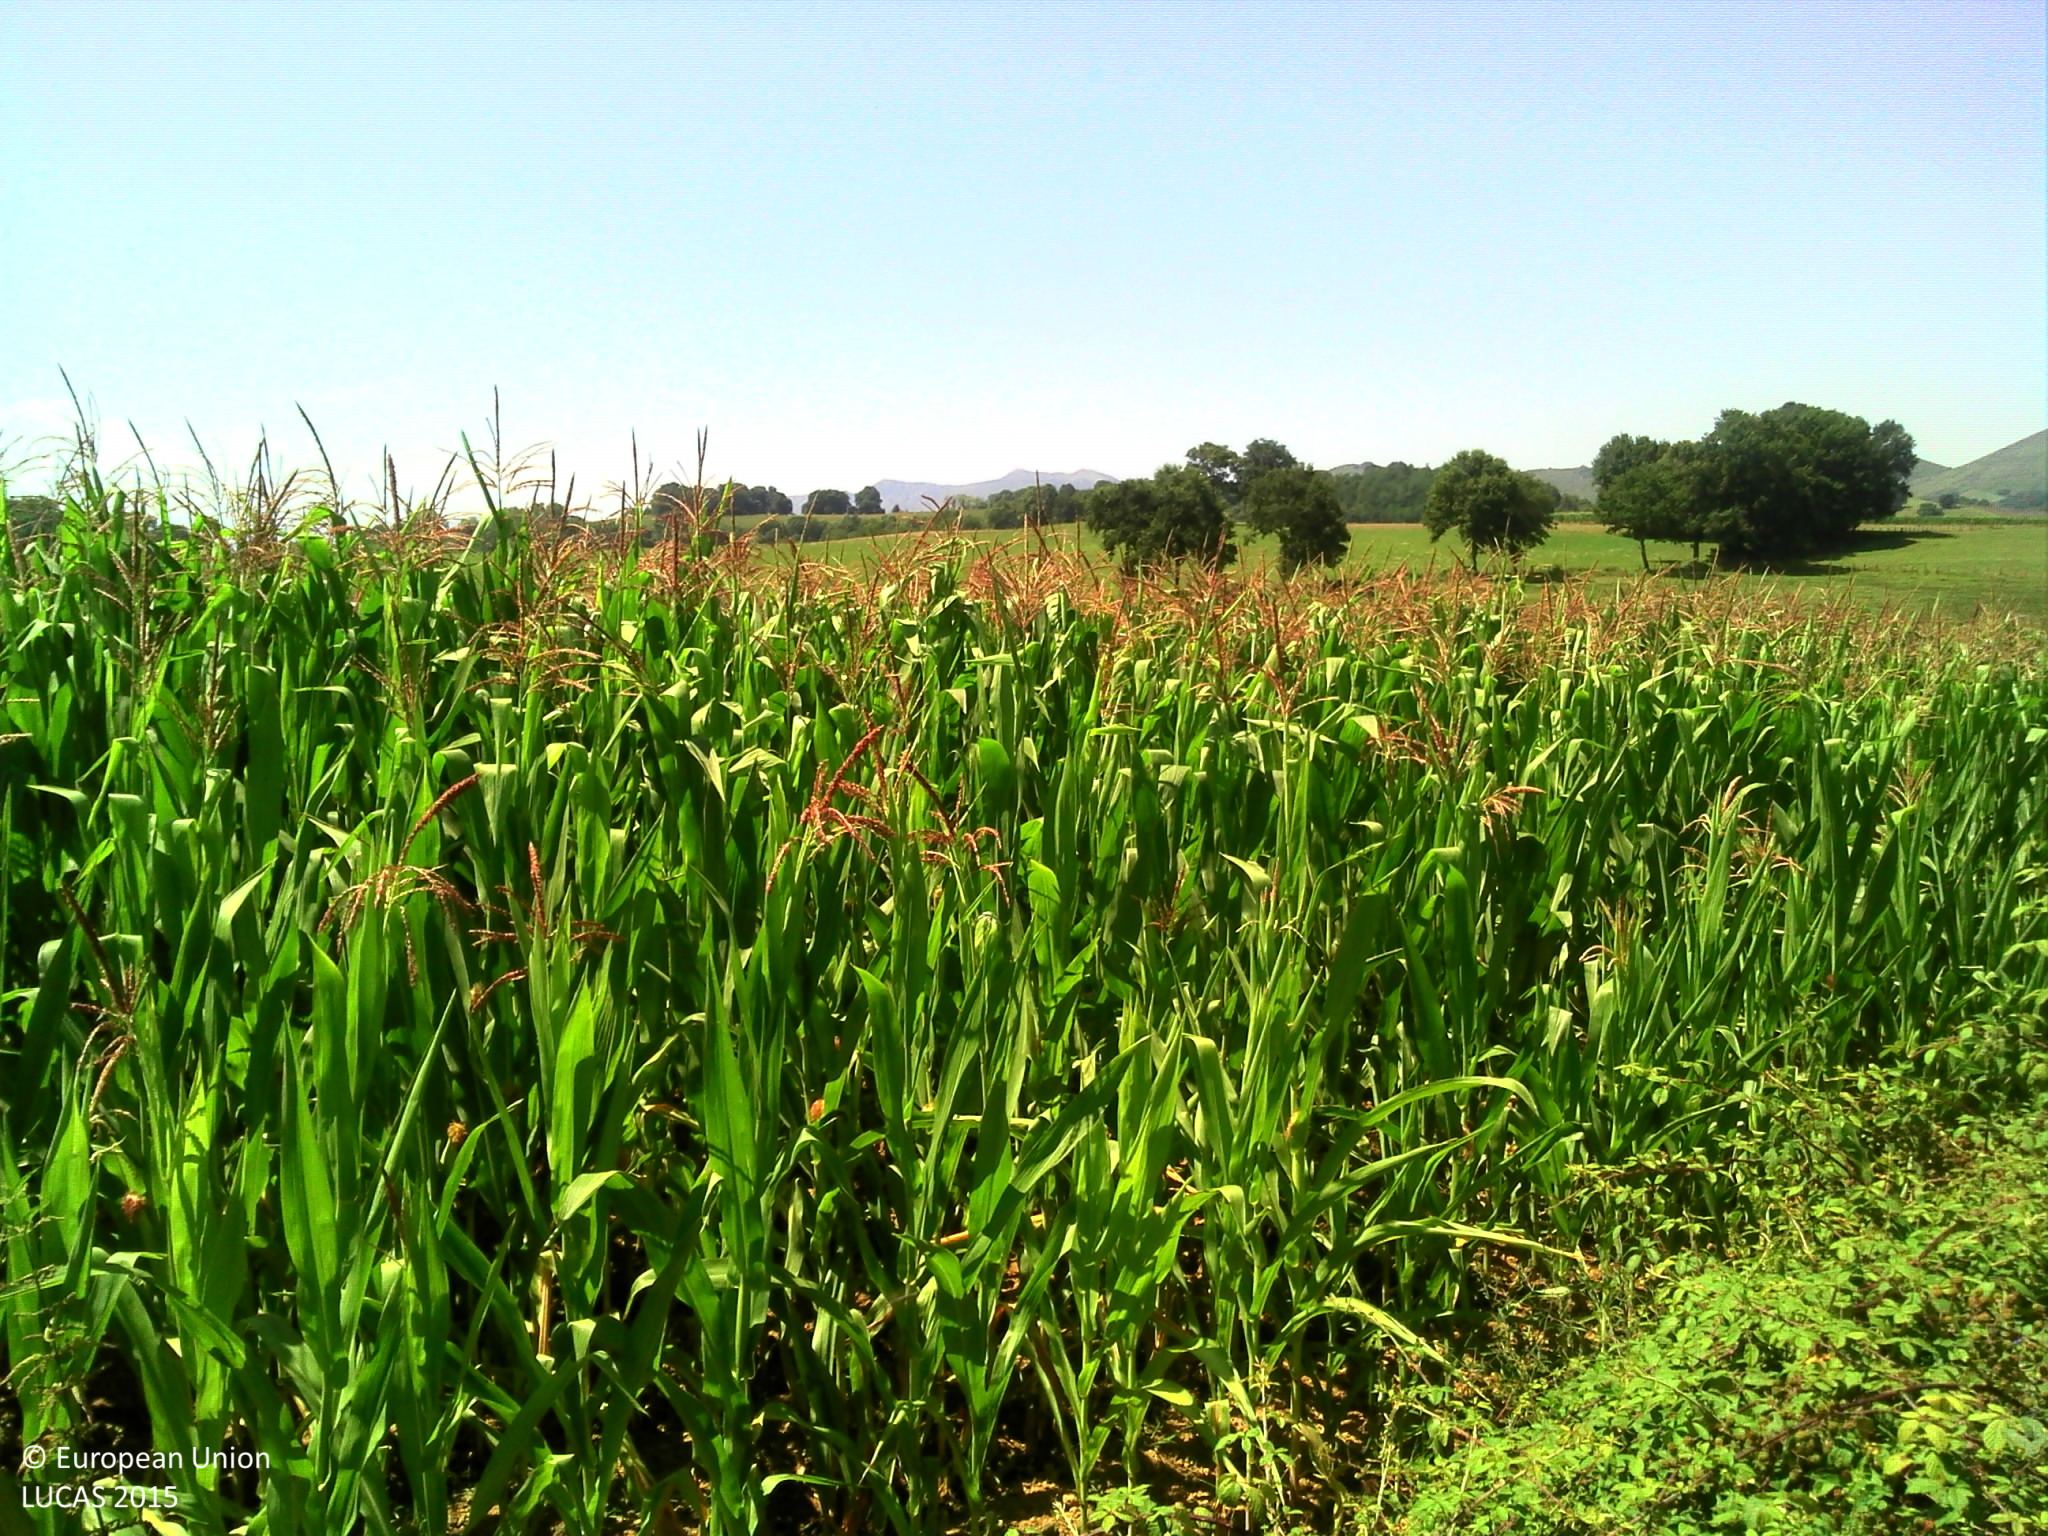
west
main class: Cropland
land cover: Maize
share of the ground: > 75 %
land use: Agriculture (excluding fallow land and kitchen gardens)
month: August
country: FR
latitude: 43.3113
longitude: -1.1469
